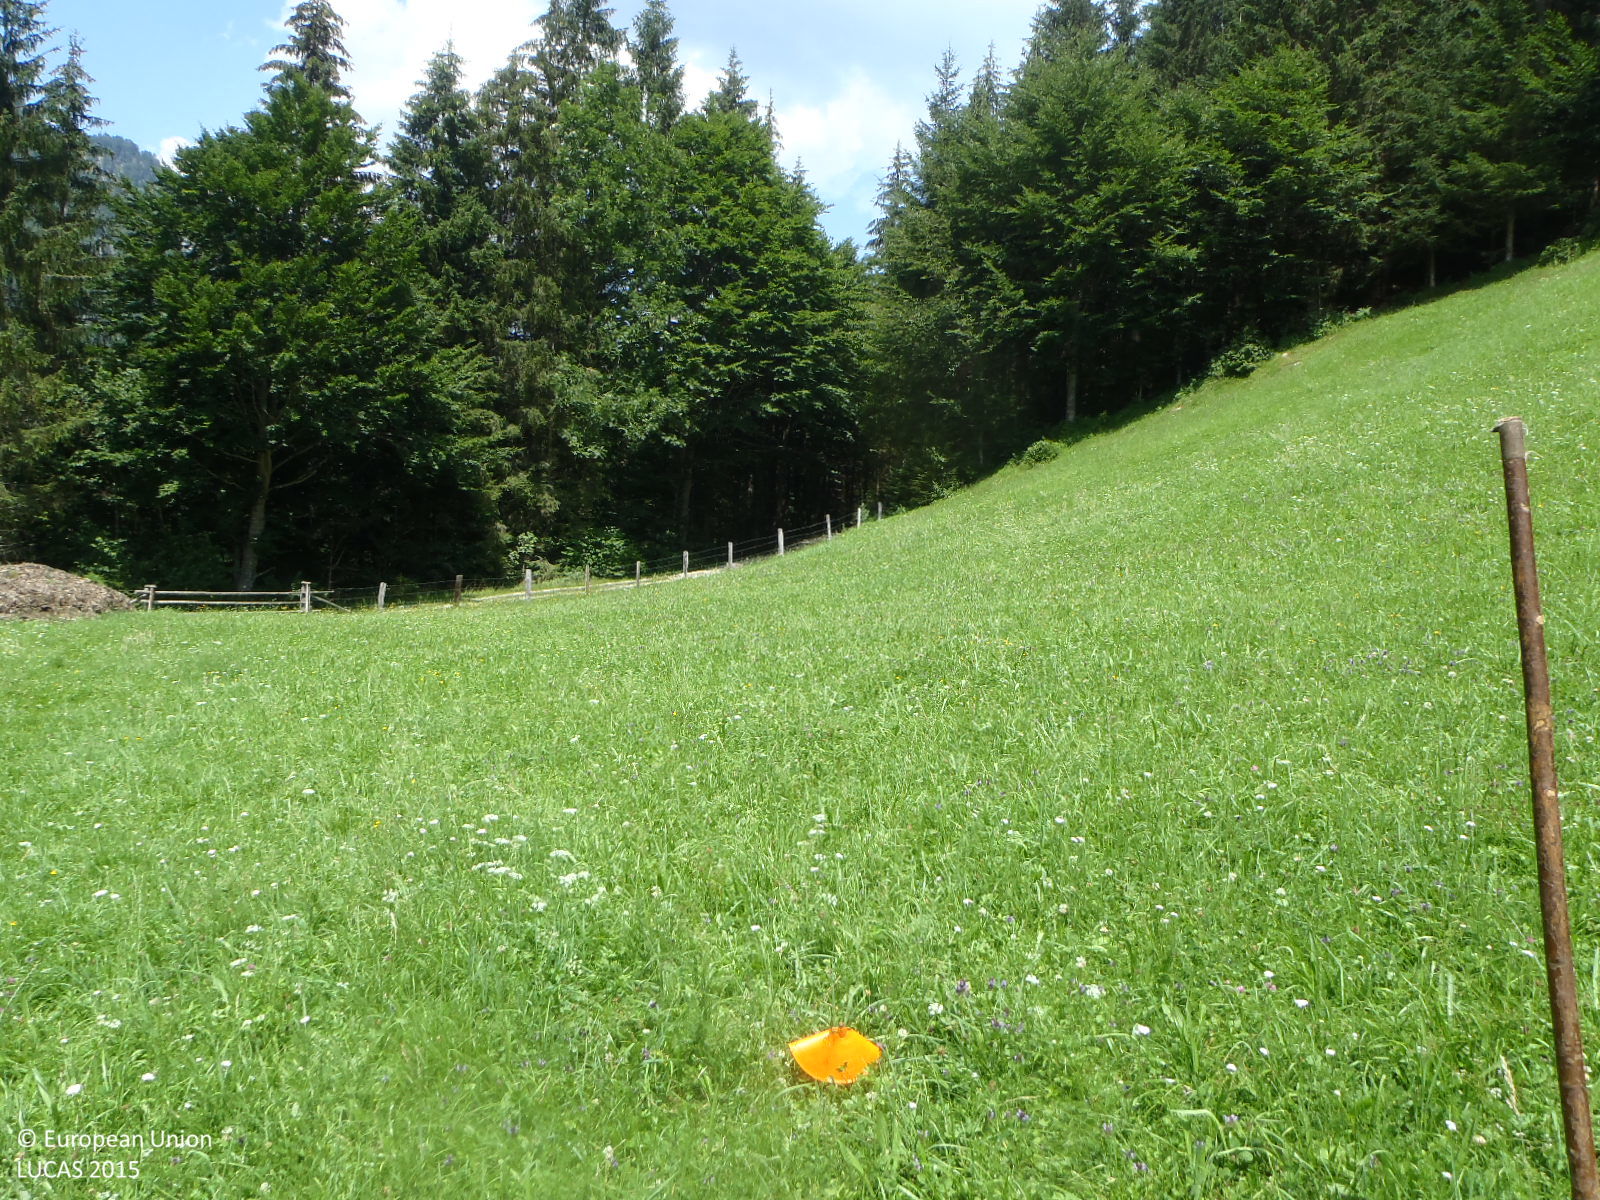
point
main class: Grassland
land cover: Grassland without tree/shrub cover
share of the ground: > 75 %
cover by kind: herbaceous plants 100 %
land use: Agriculture (excluding fallow land and kitchen gardens)
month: July
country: AT
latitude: 47.5231
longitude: 11.8978
